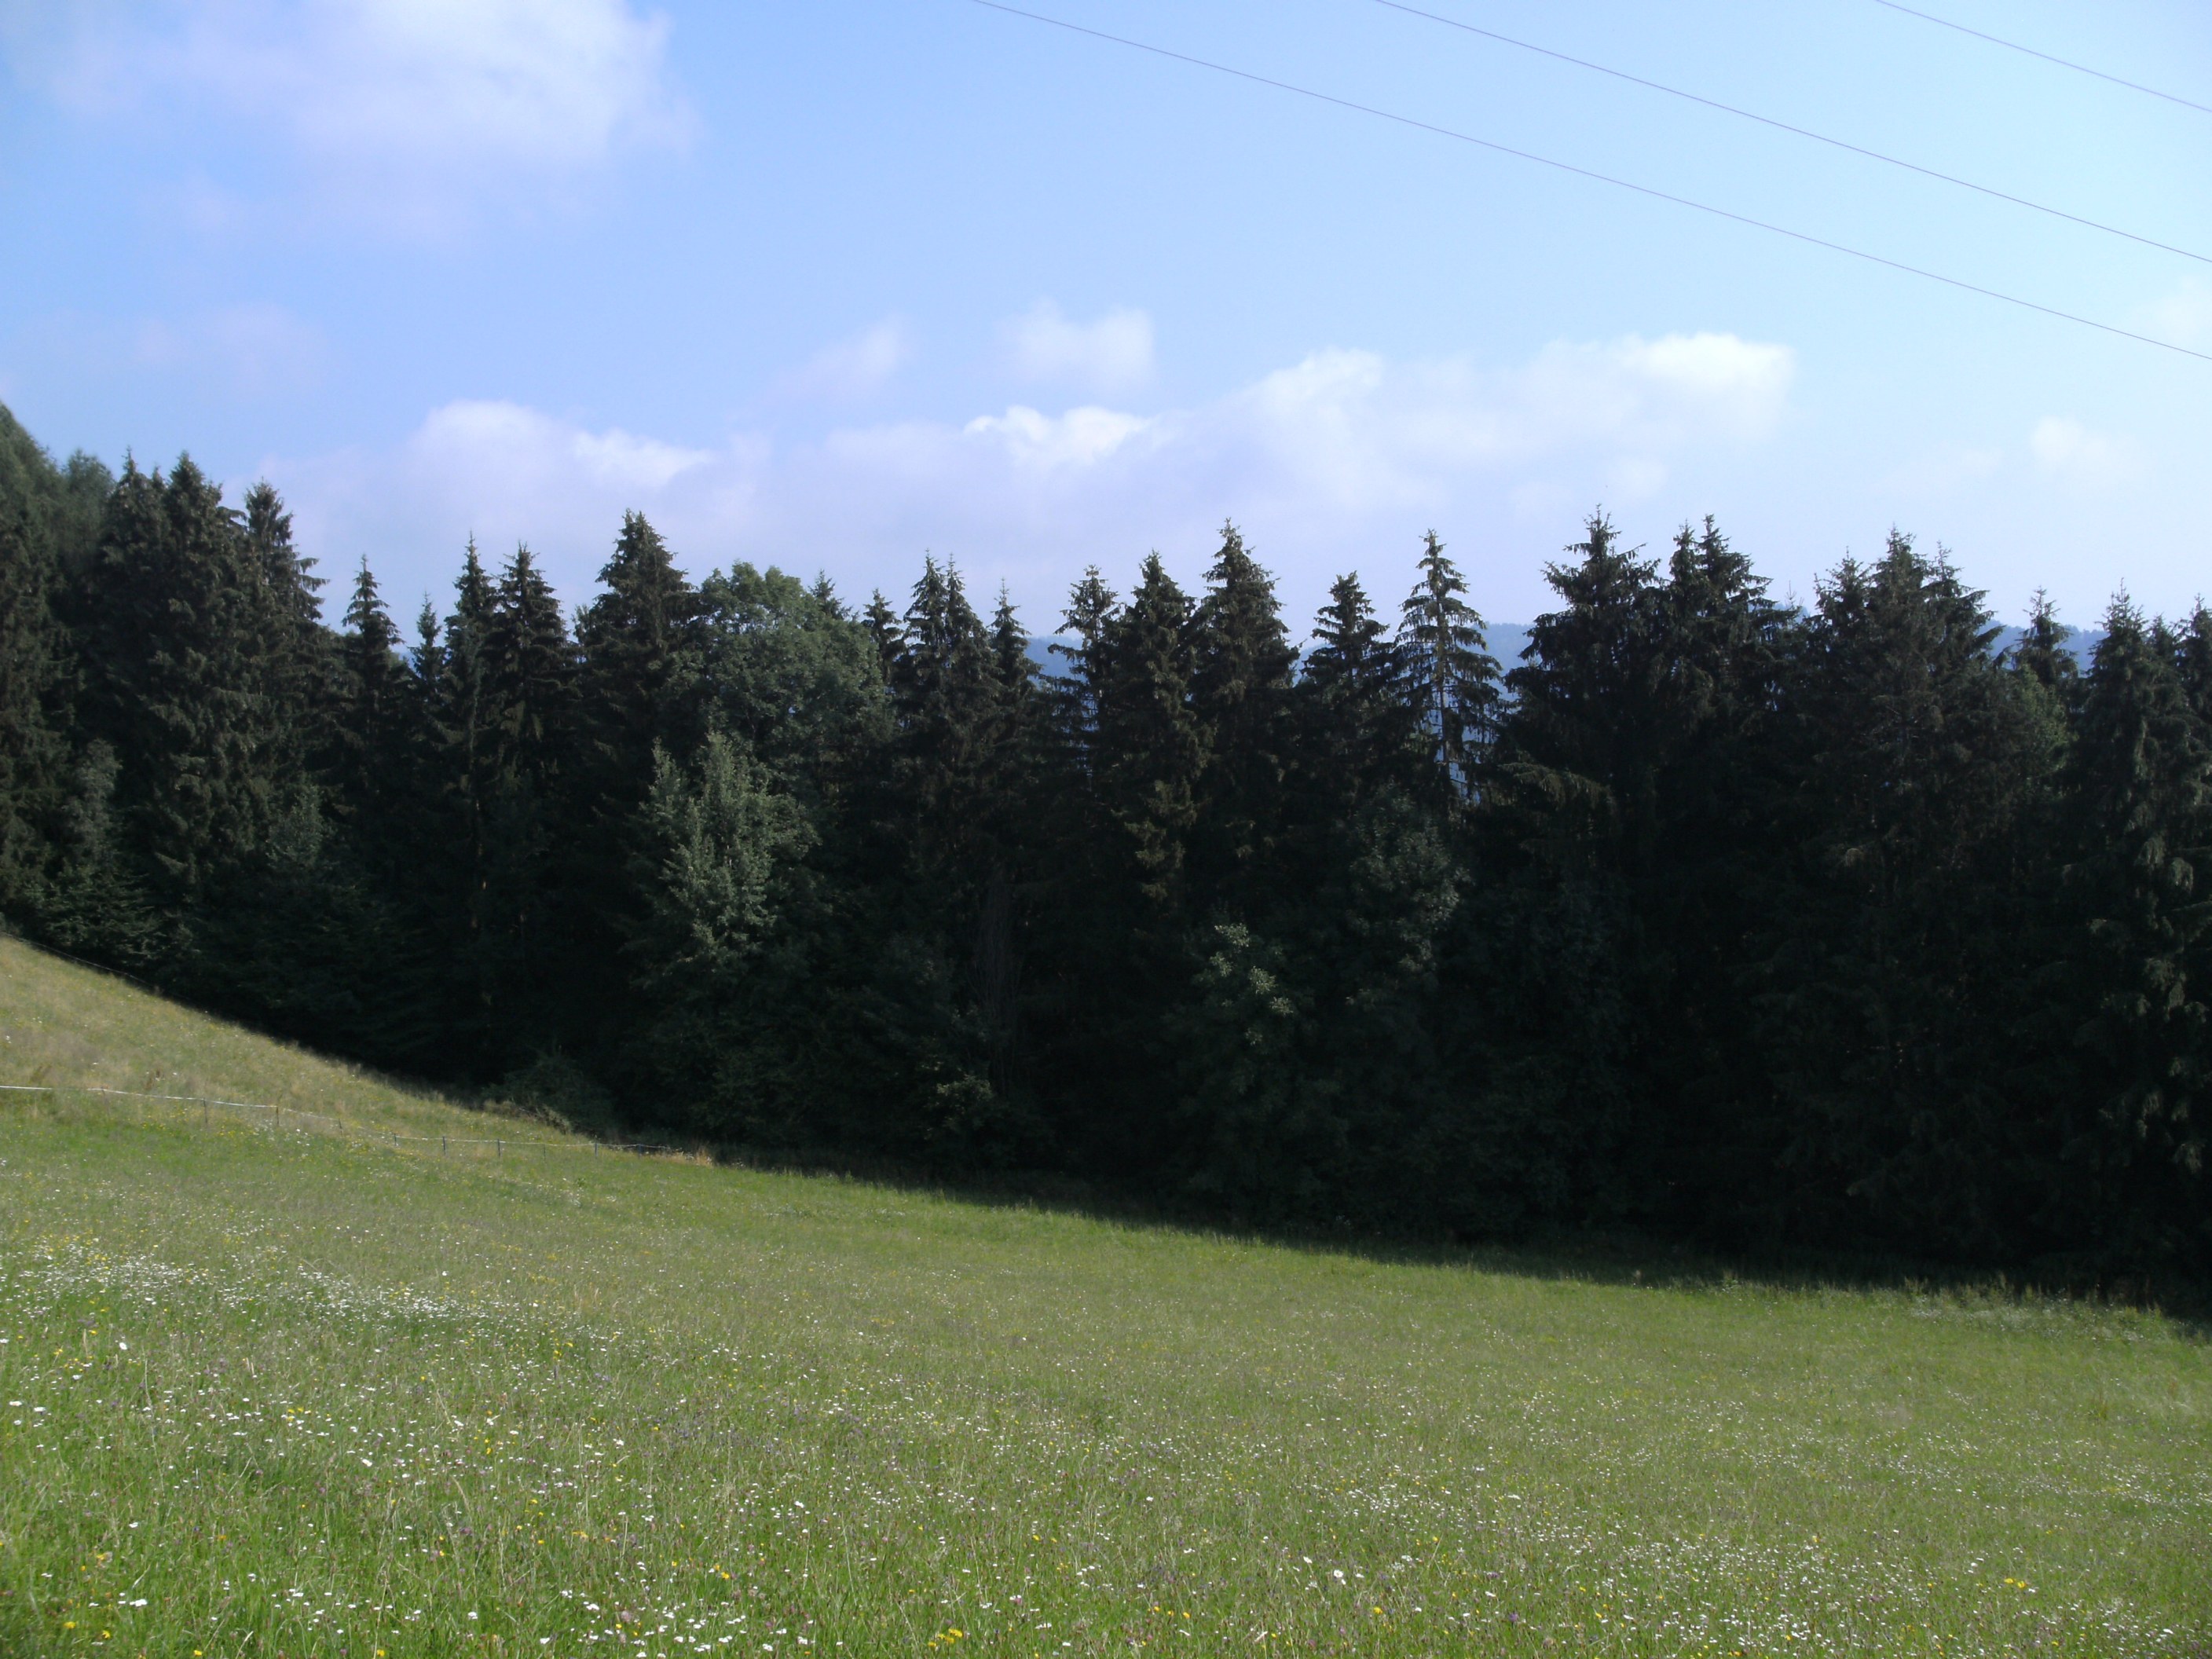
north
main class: Grassland
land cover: Grassland without tree/shrub cover
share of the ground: > 75 %
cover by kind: herbaceous plants 100 %
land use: Agriculture (excluding fallow land and kitchen gardens)
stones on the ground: < 10 %
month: July
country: AT
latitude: 46.7317
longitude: 14.7744
